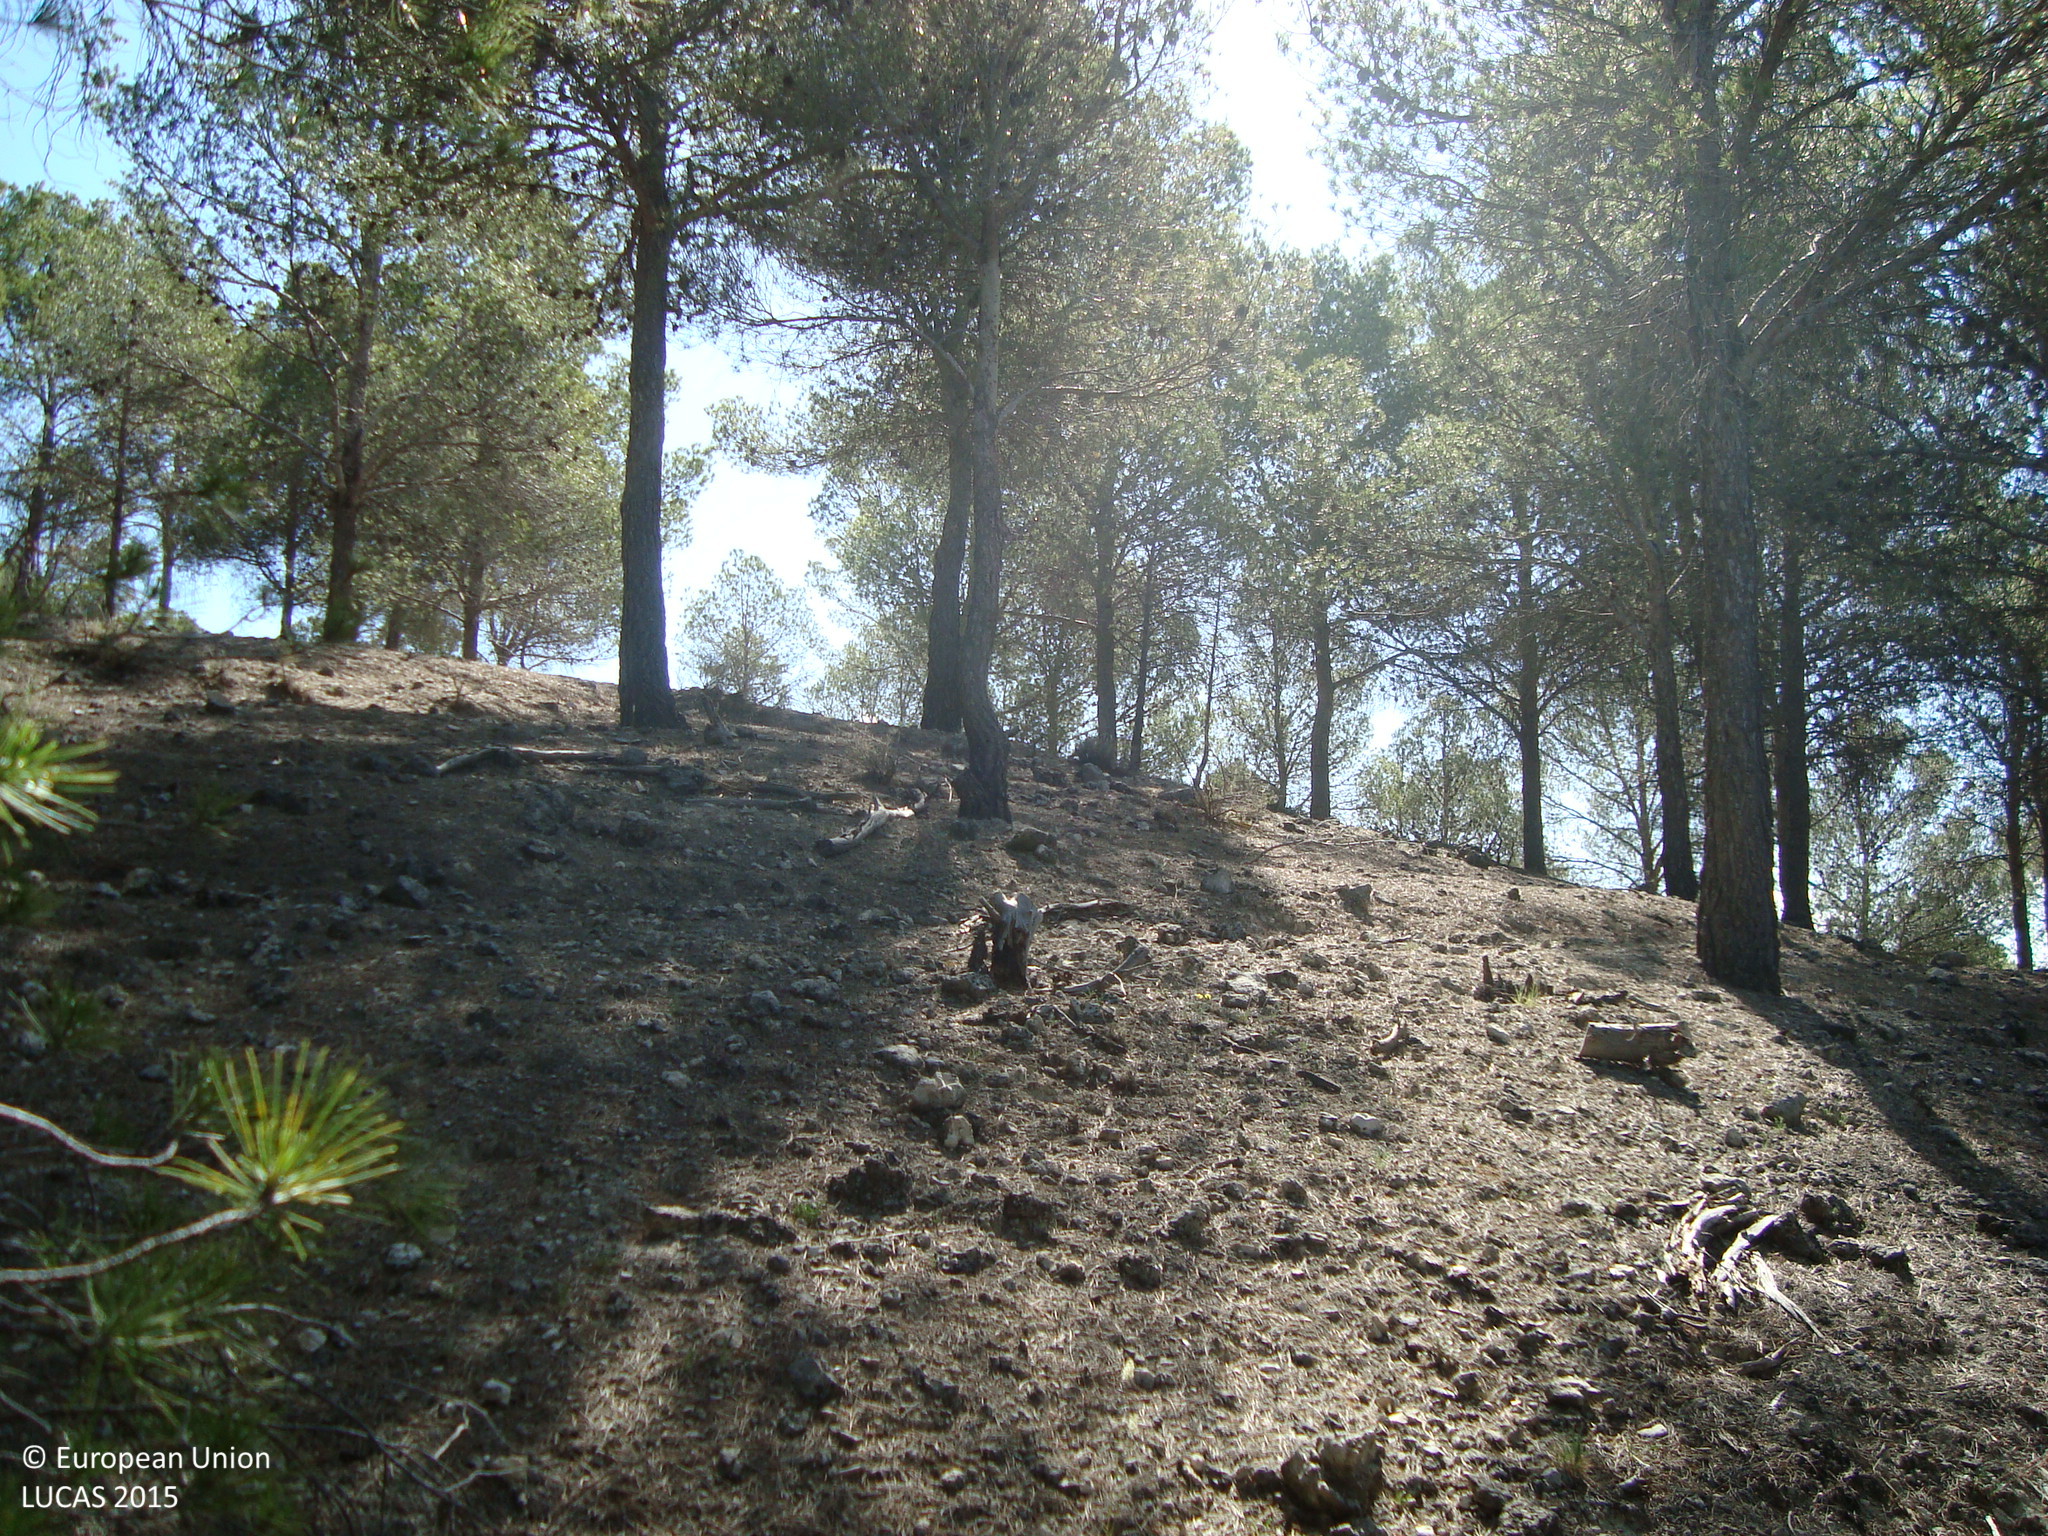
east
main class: Woodland
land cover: Pine dominated coniferous woodland
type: coniferous forest of the mediterranean region
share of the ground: > 75 %
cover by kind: coniferous forest trees 80 %, unconsolidated bare surface 10 %, shrubs 5 %, herbaceous plants 5 %
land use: Forestry
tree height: > 5 m
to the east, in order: Pine dominated coniferous woodland; Tracks; Grassland with sparse tree/shrub cover; Pine dominated coniferous woodland; Tracks; Spontaneously vegetated surfaces
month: May
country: ES
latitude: 41.4208
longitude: -4.6258
